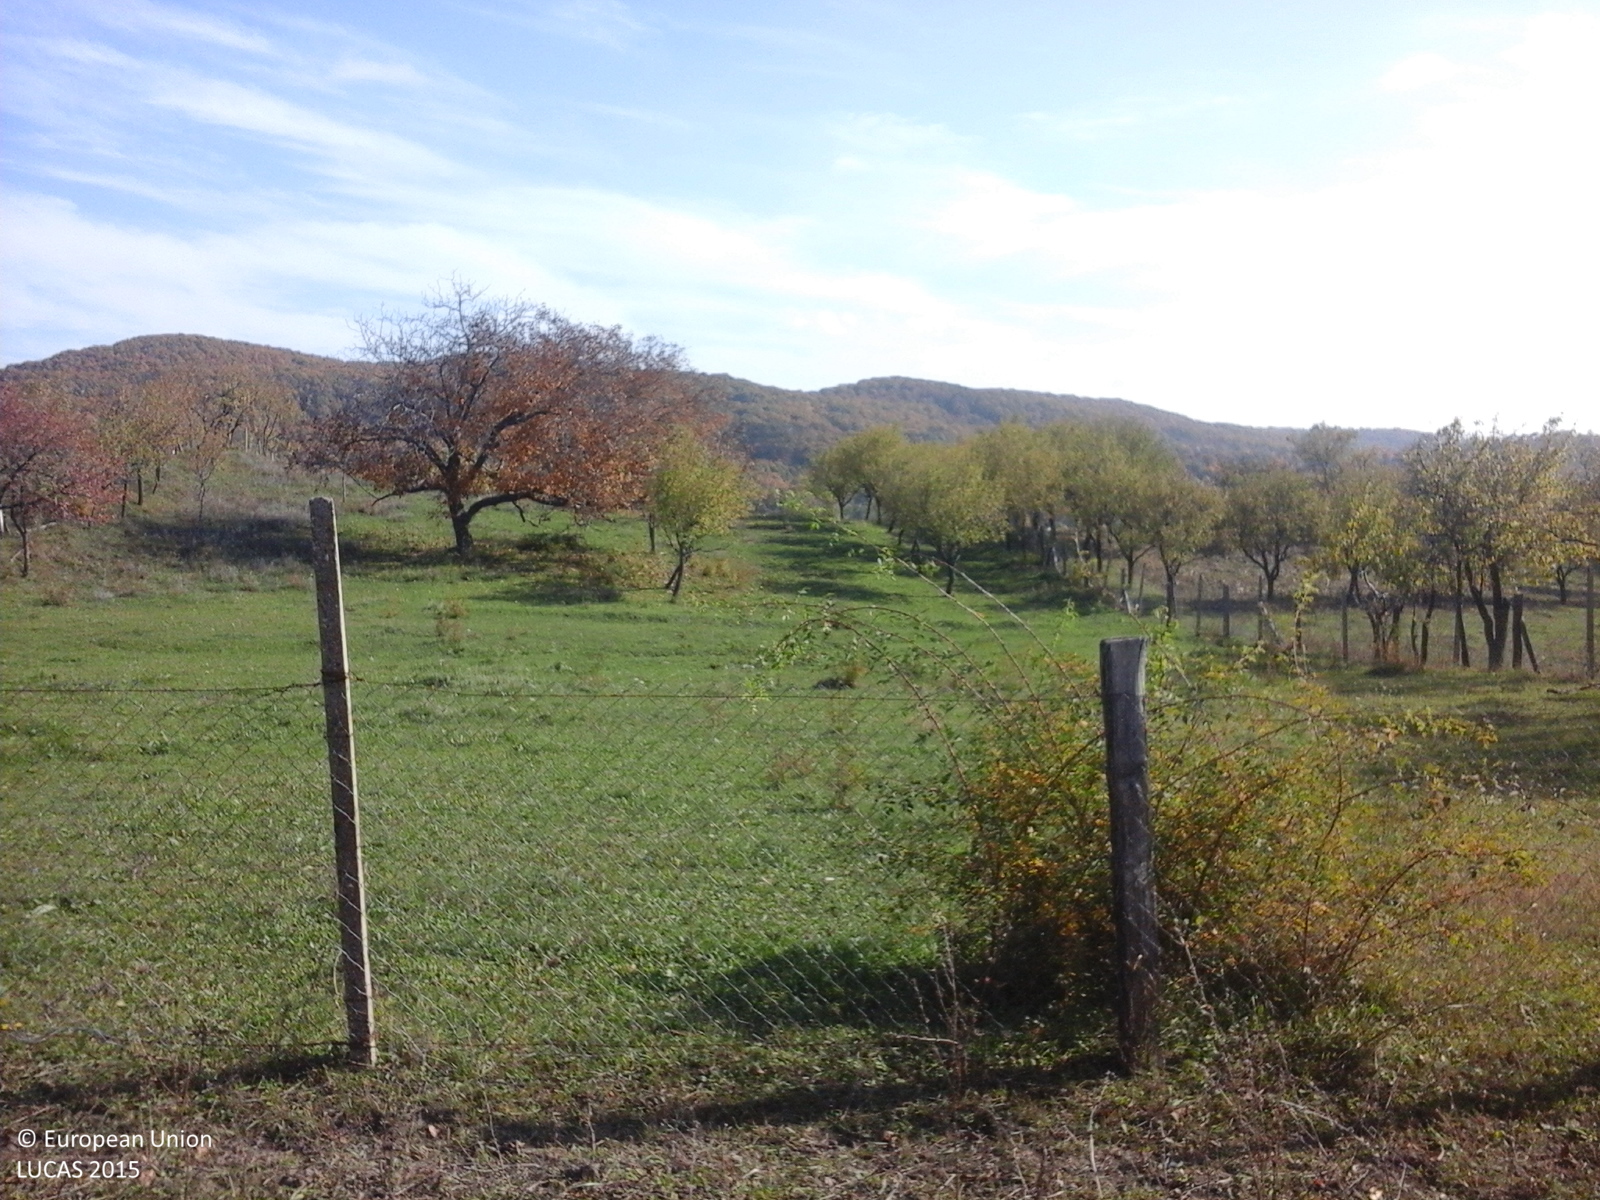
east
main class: Cropland
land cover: Nuts trees
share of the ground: > 75 %
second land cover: Grassland without tree/shrub cover
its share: > 75 %
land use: Agriculture (excluding fallow land and kitchen gardens)
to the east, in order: Nuts trees; Grassland without tree/shrub cover; Fences; Grassland without tree/shrub cover; Fences; Other fruit trees and berries; Fences; Grass margins; Tracks; Grass margins; Fences; Broadleaved woodland; Fences; Vineyards
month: October
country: RO
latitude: 45.6594
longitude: 26.9913
